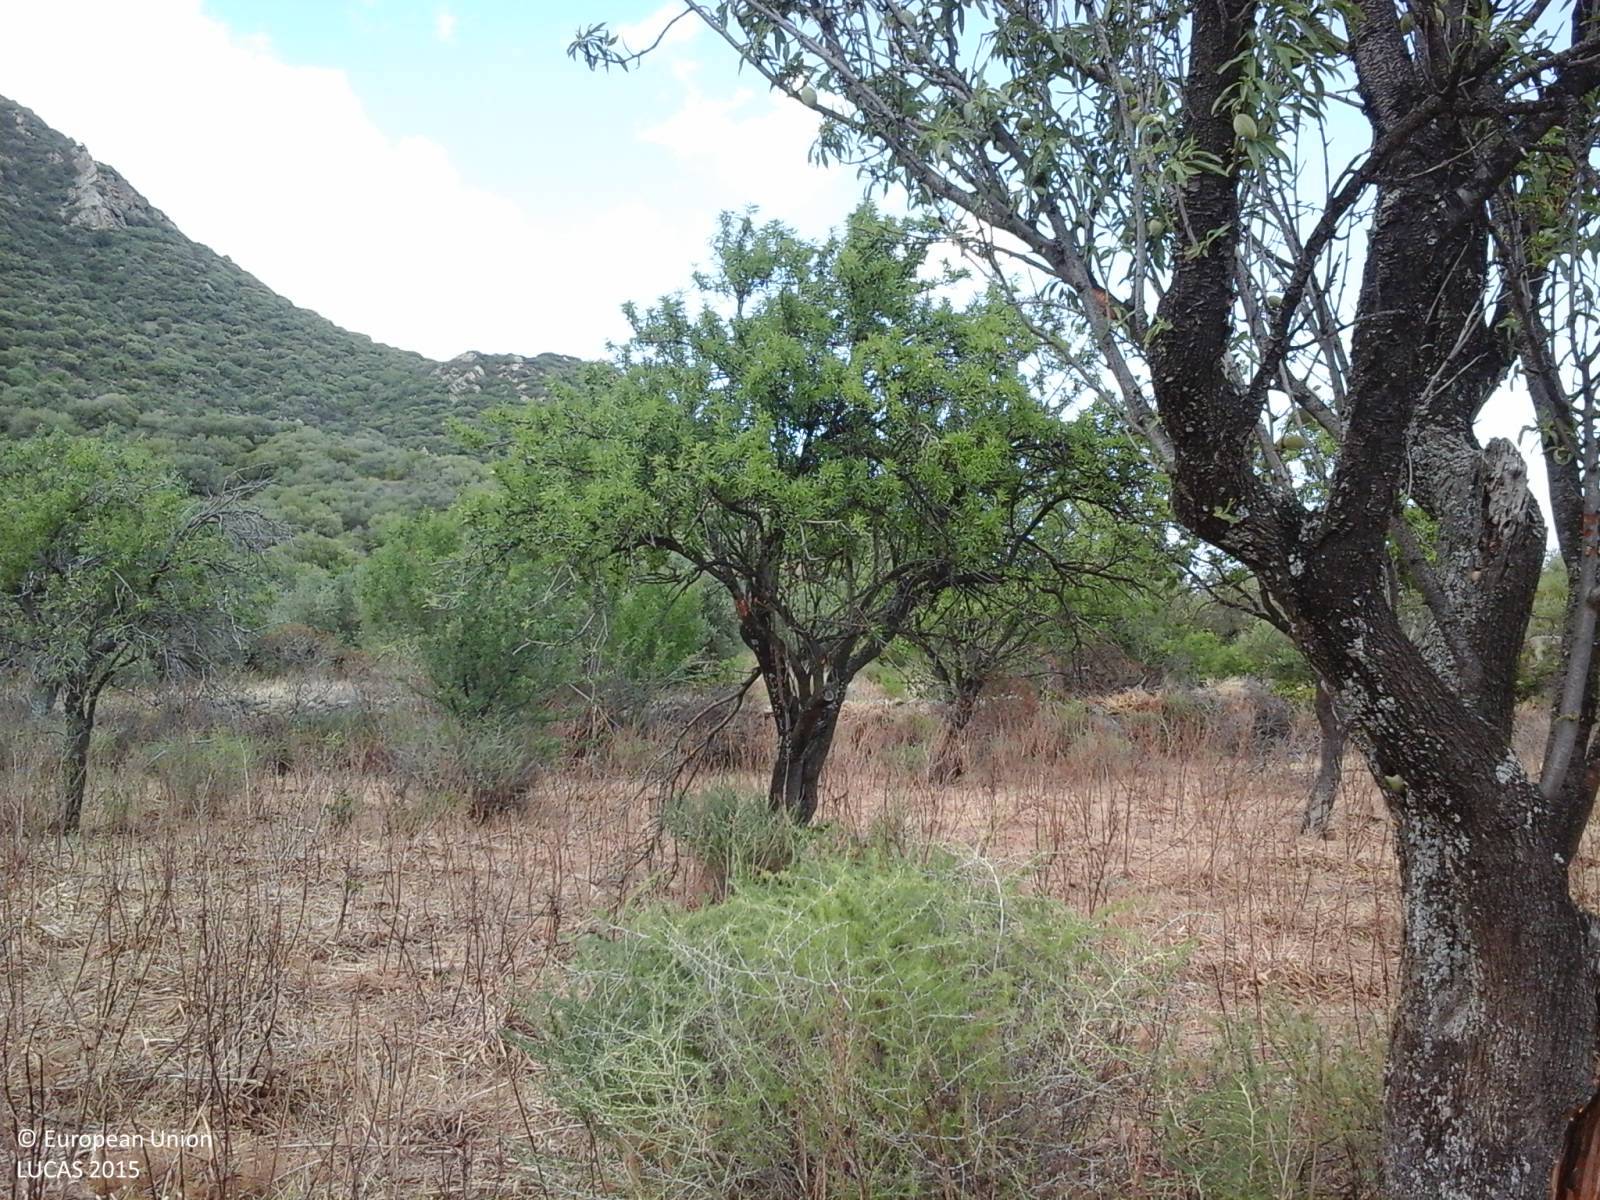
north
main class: Cropland
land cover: Nuts trees
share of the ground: > 75 %
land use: Agriculture (excluding fallow land and kitchen gardens)
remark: Burnt area
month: May
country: IT
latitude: 40.3020
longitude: 9.4499
